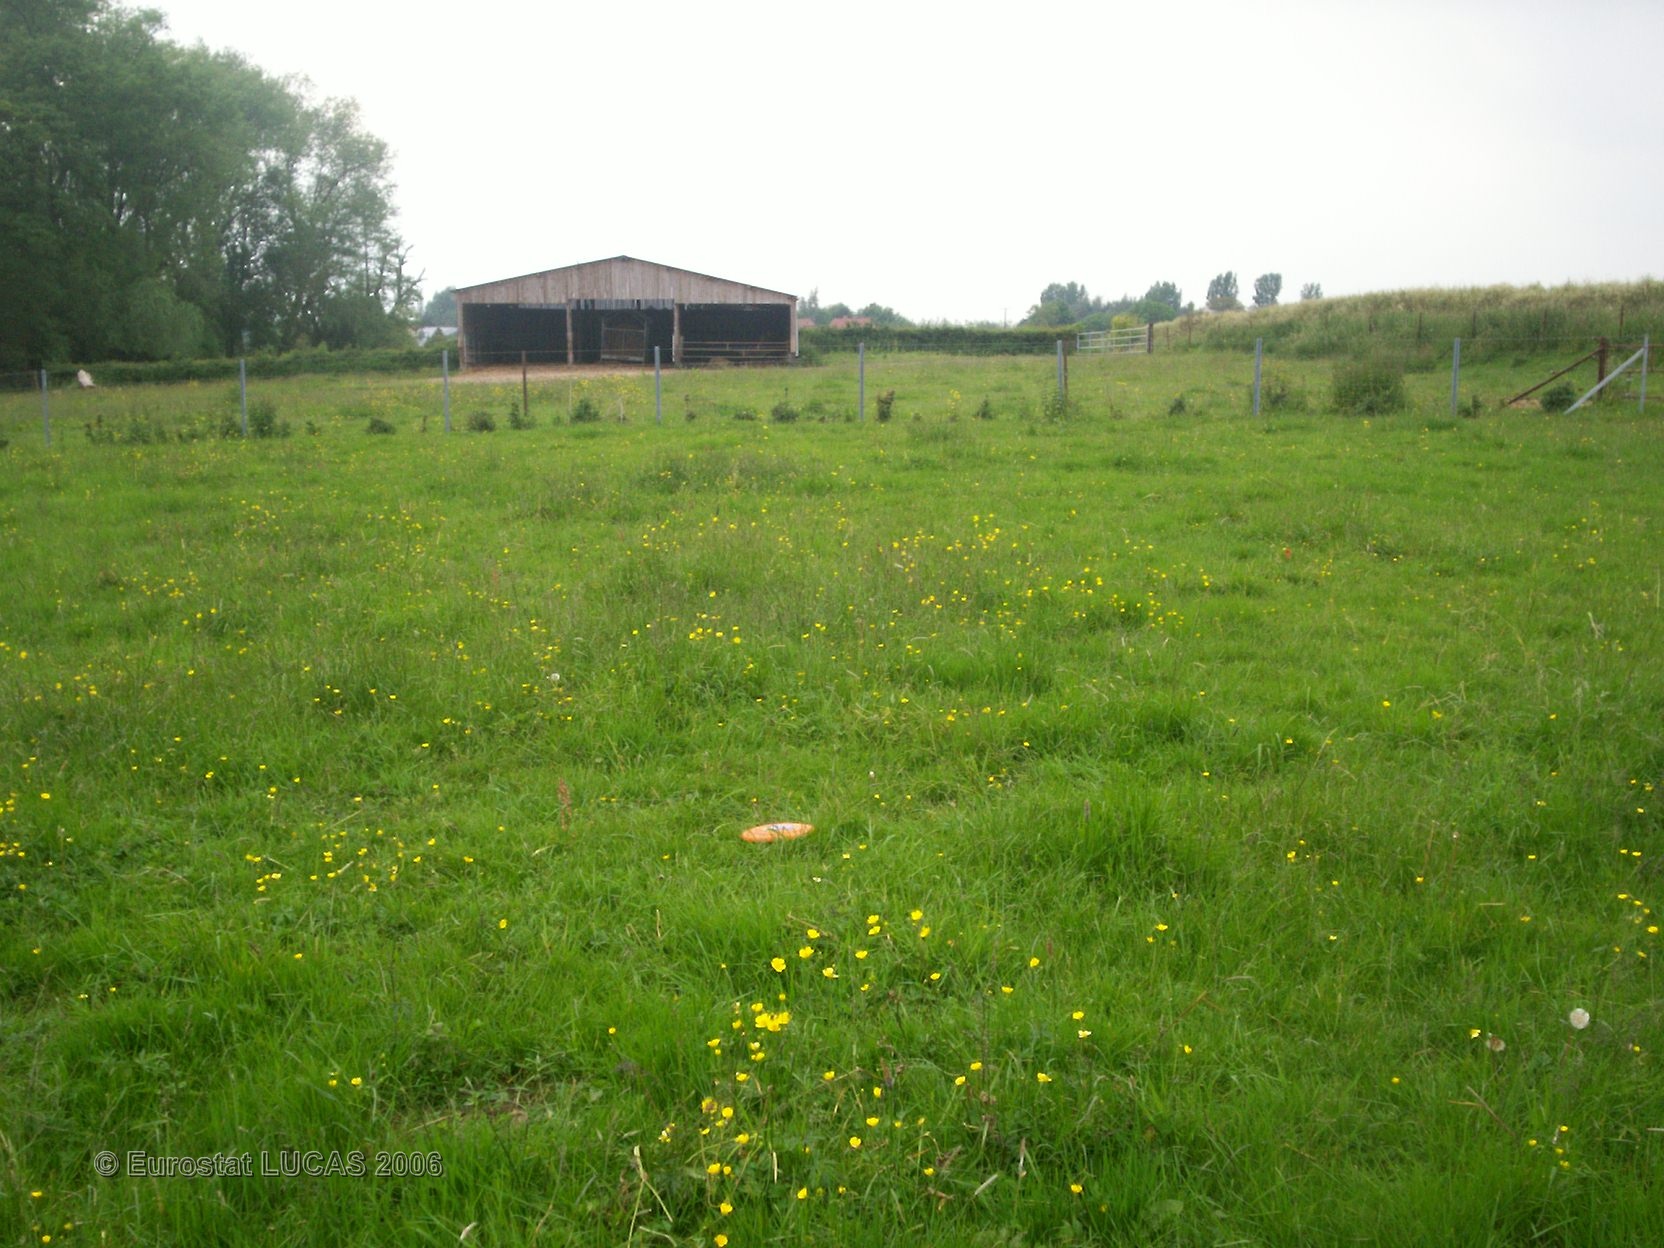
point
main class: Grassland
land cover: Grassland without tree/shrub cover
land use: Agriculture (excluding fallow land and kitchen gardens)
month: June
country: FR
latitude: 50.3160
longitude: 3.6875
